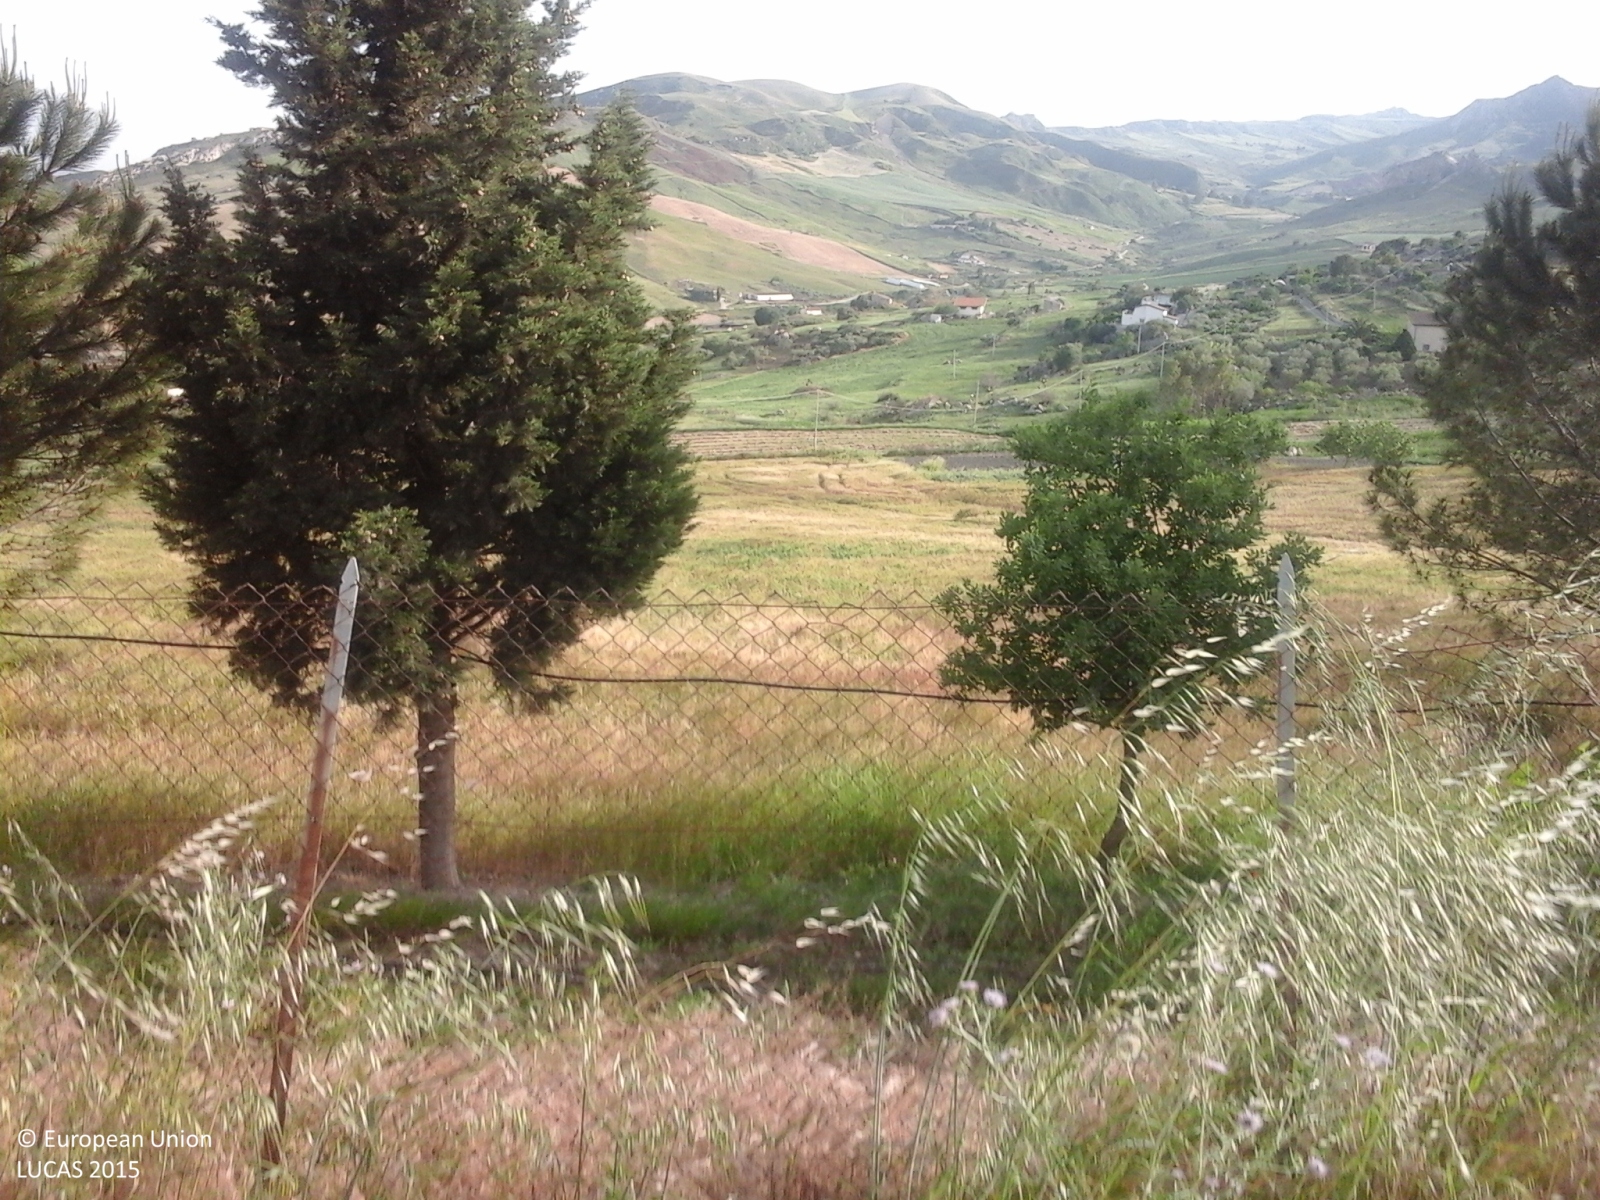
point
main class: Cropland
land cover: Durum wheat
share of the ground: > 75 %
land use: Agriculture (excluding fallow land and kitchen gardens)
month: May
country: IT
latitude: 37.6219
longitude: 13.6776
